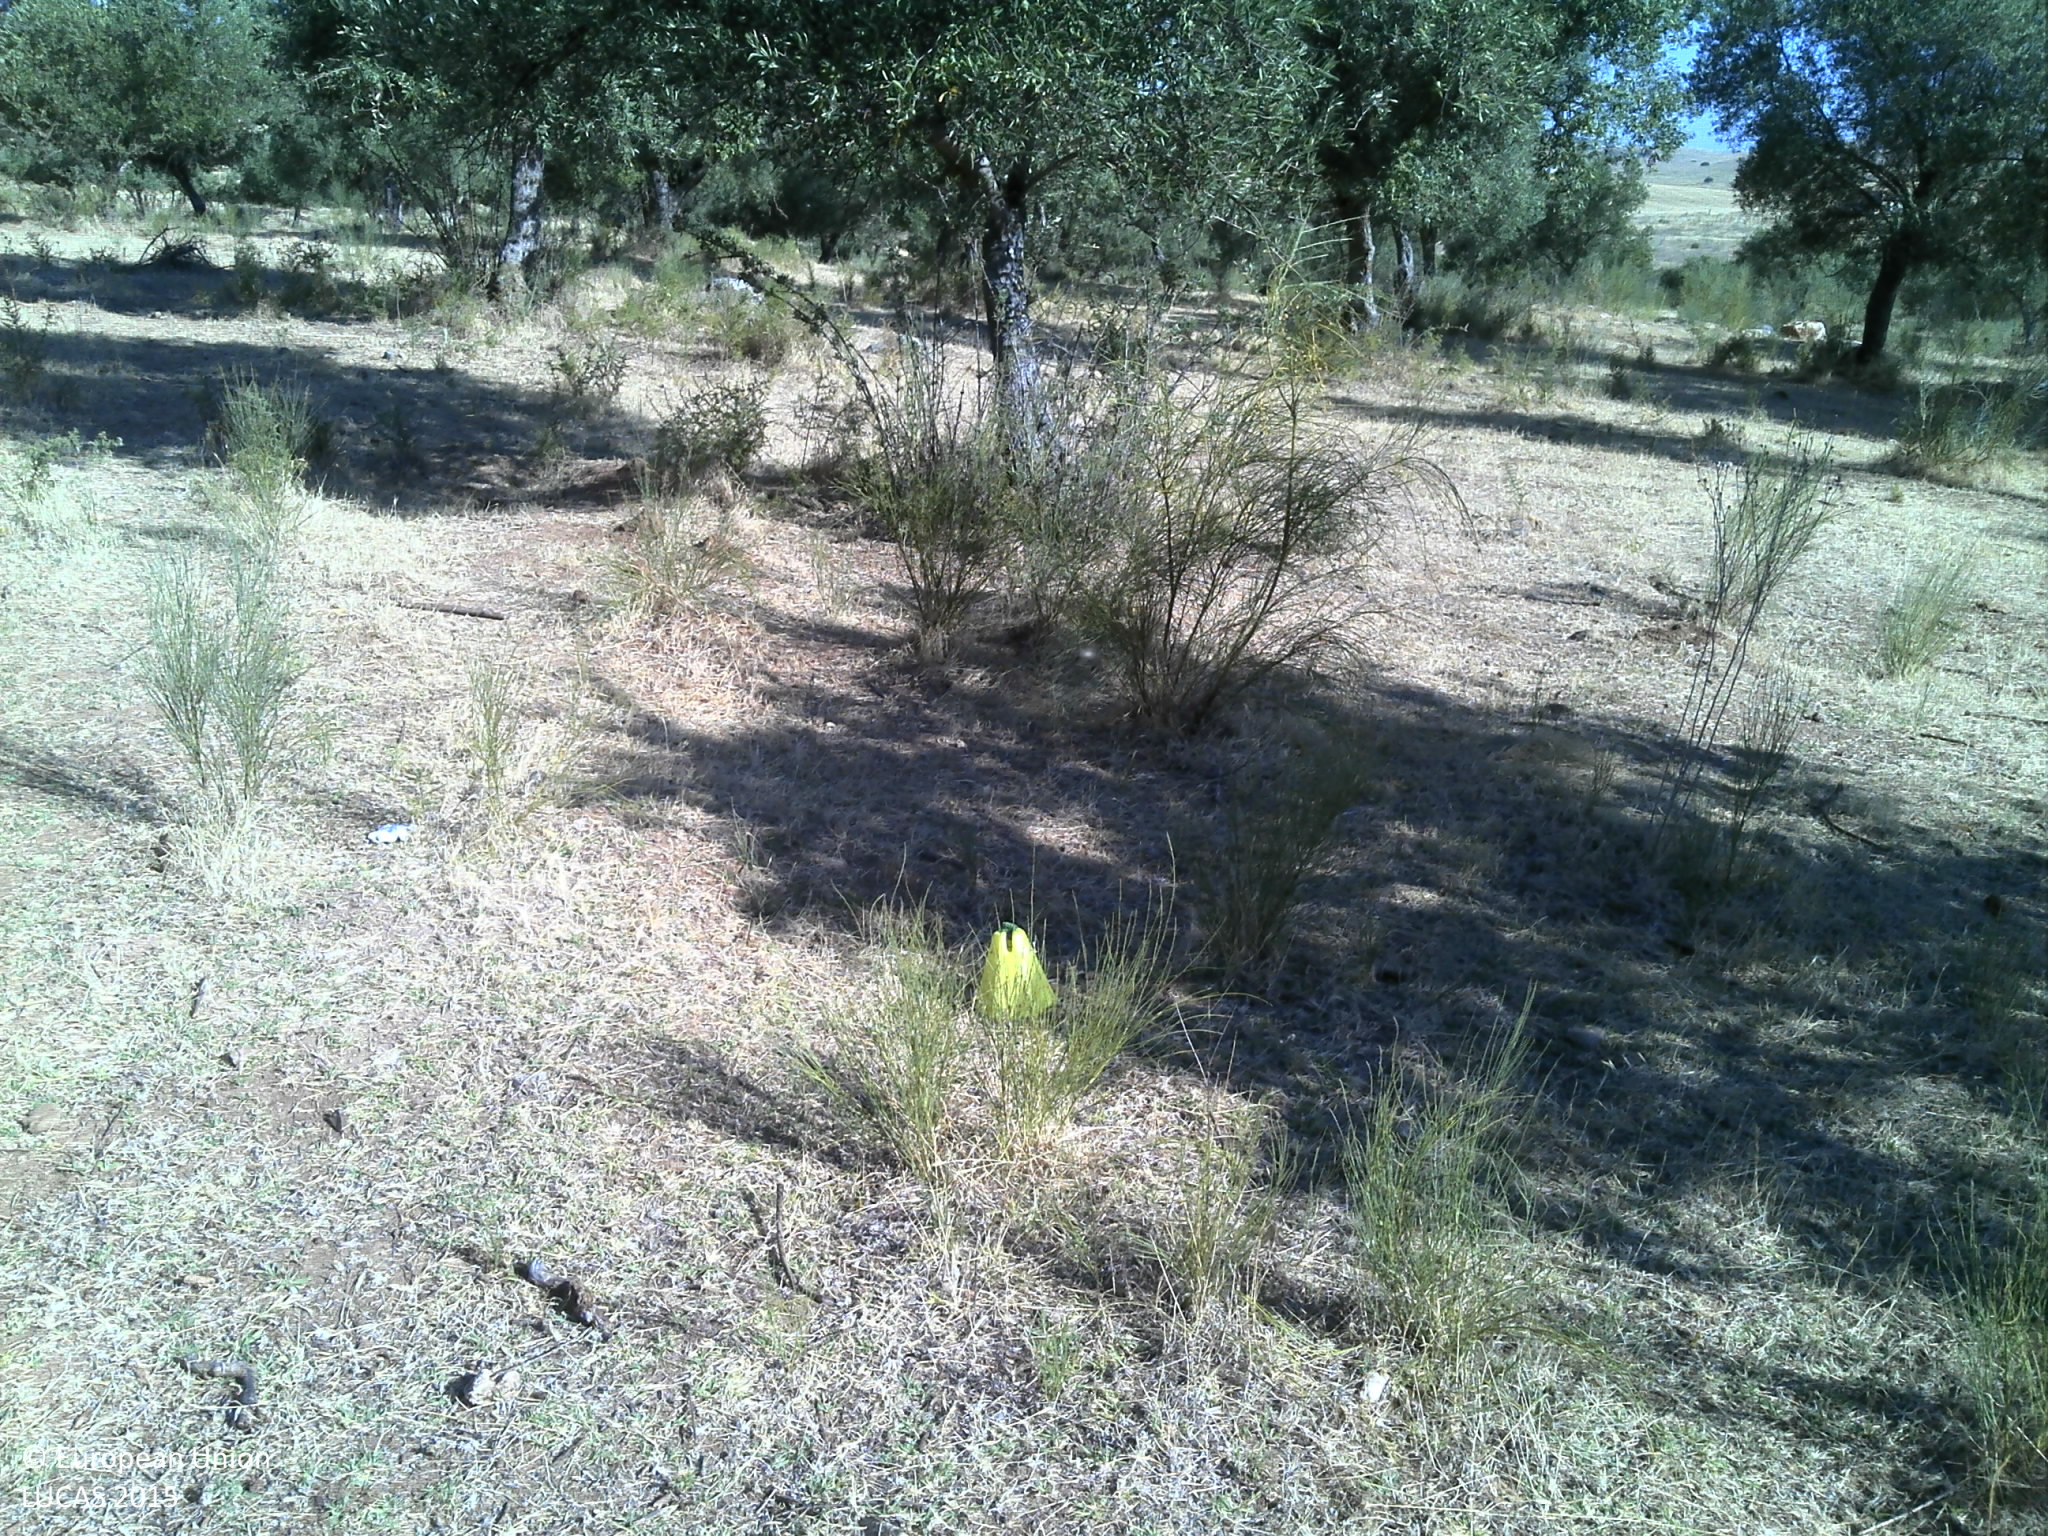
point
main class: Cropland
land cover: Olive groves
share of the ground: 25 - 50 %
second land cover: Grassland without tree/shrub cover
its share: < 10 %
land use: Agriculture (excluding fallow land and kitchen gardens)
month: July
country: PT
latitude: 38.9180
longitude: -7.1084
